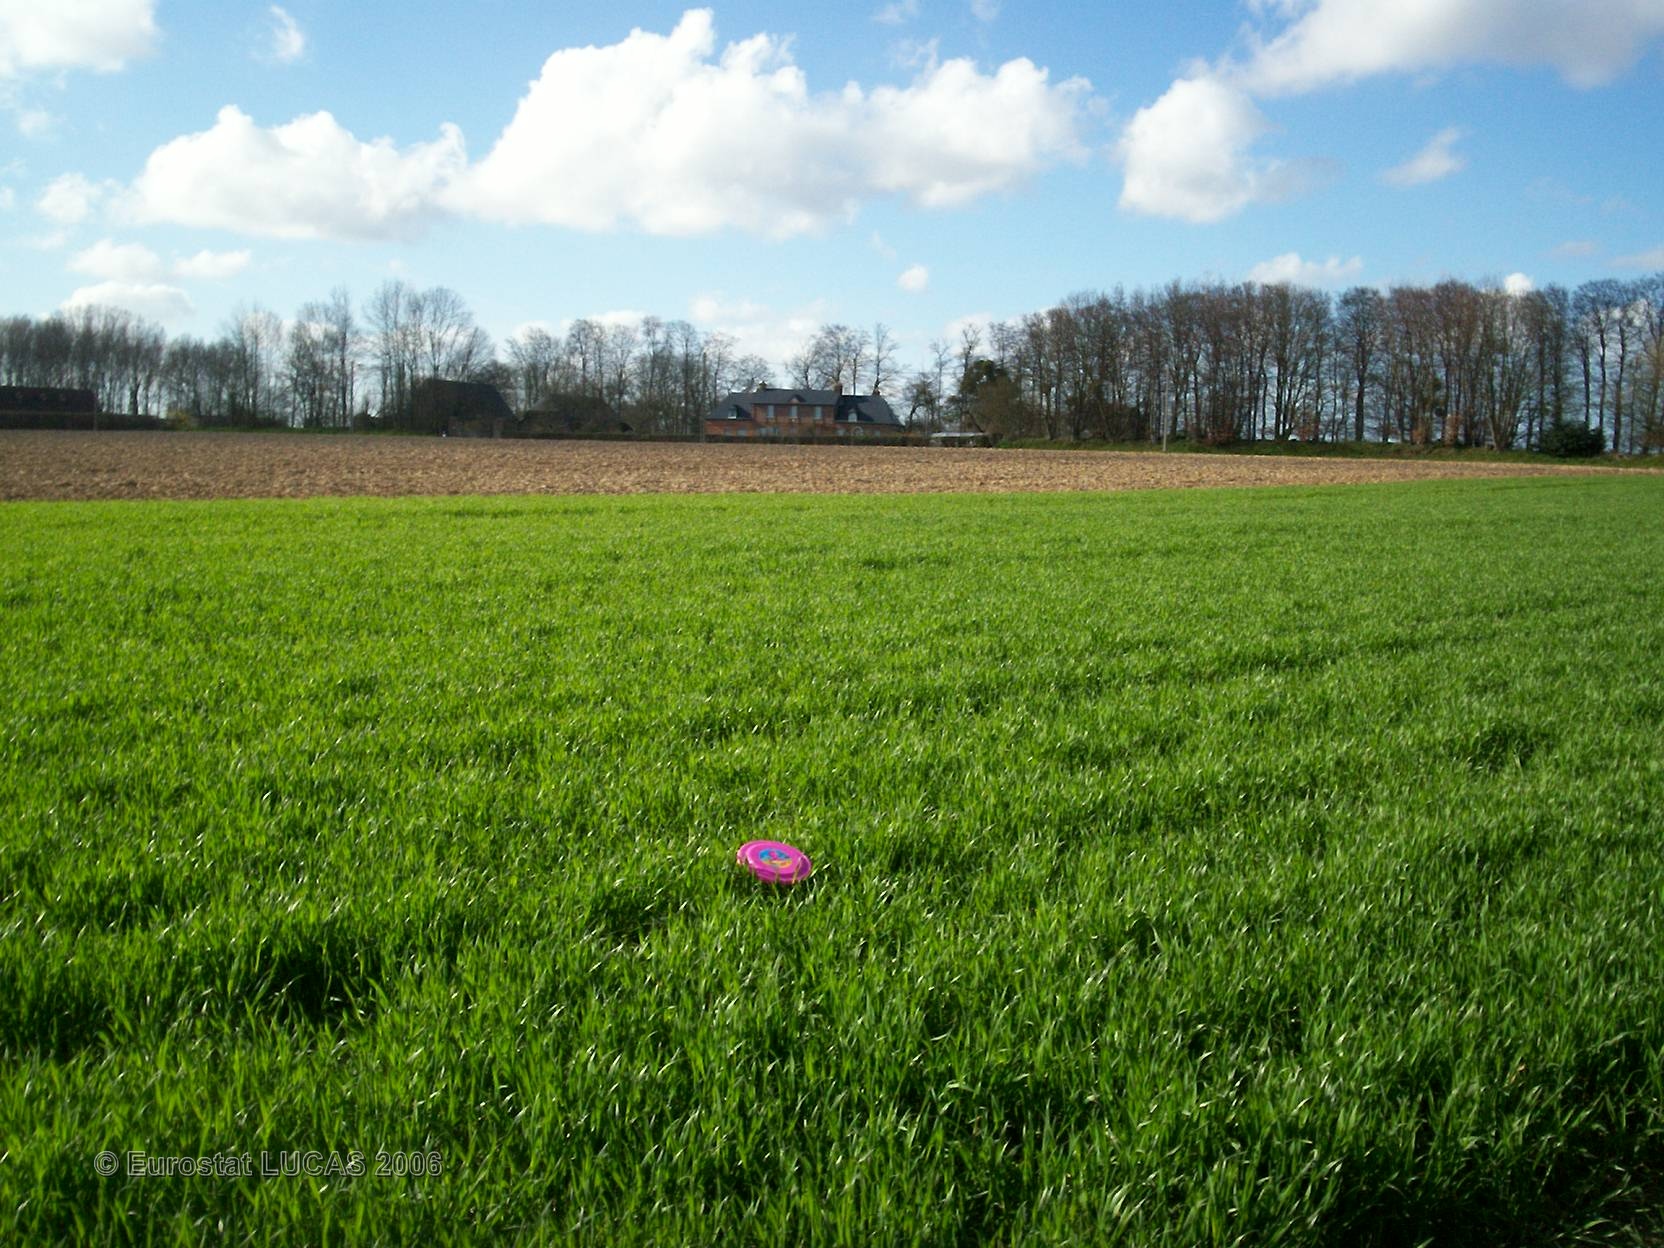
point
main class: Cropland
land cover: Common wheat
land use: Agriculture (excluding fallow land and kitchen gardens)
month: April
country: FR
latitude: 49.6058
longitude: 0.9409
